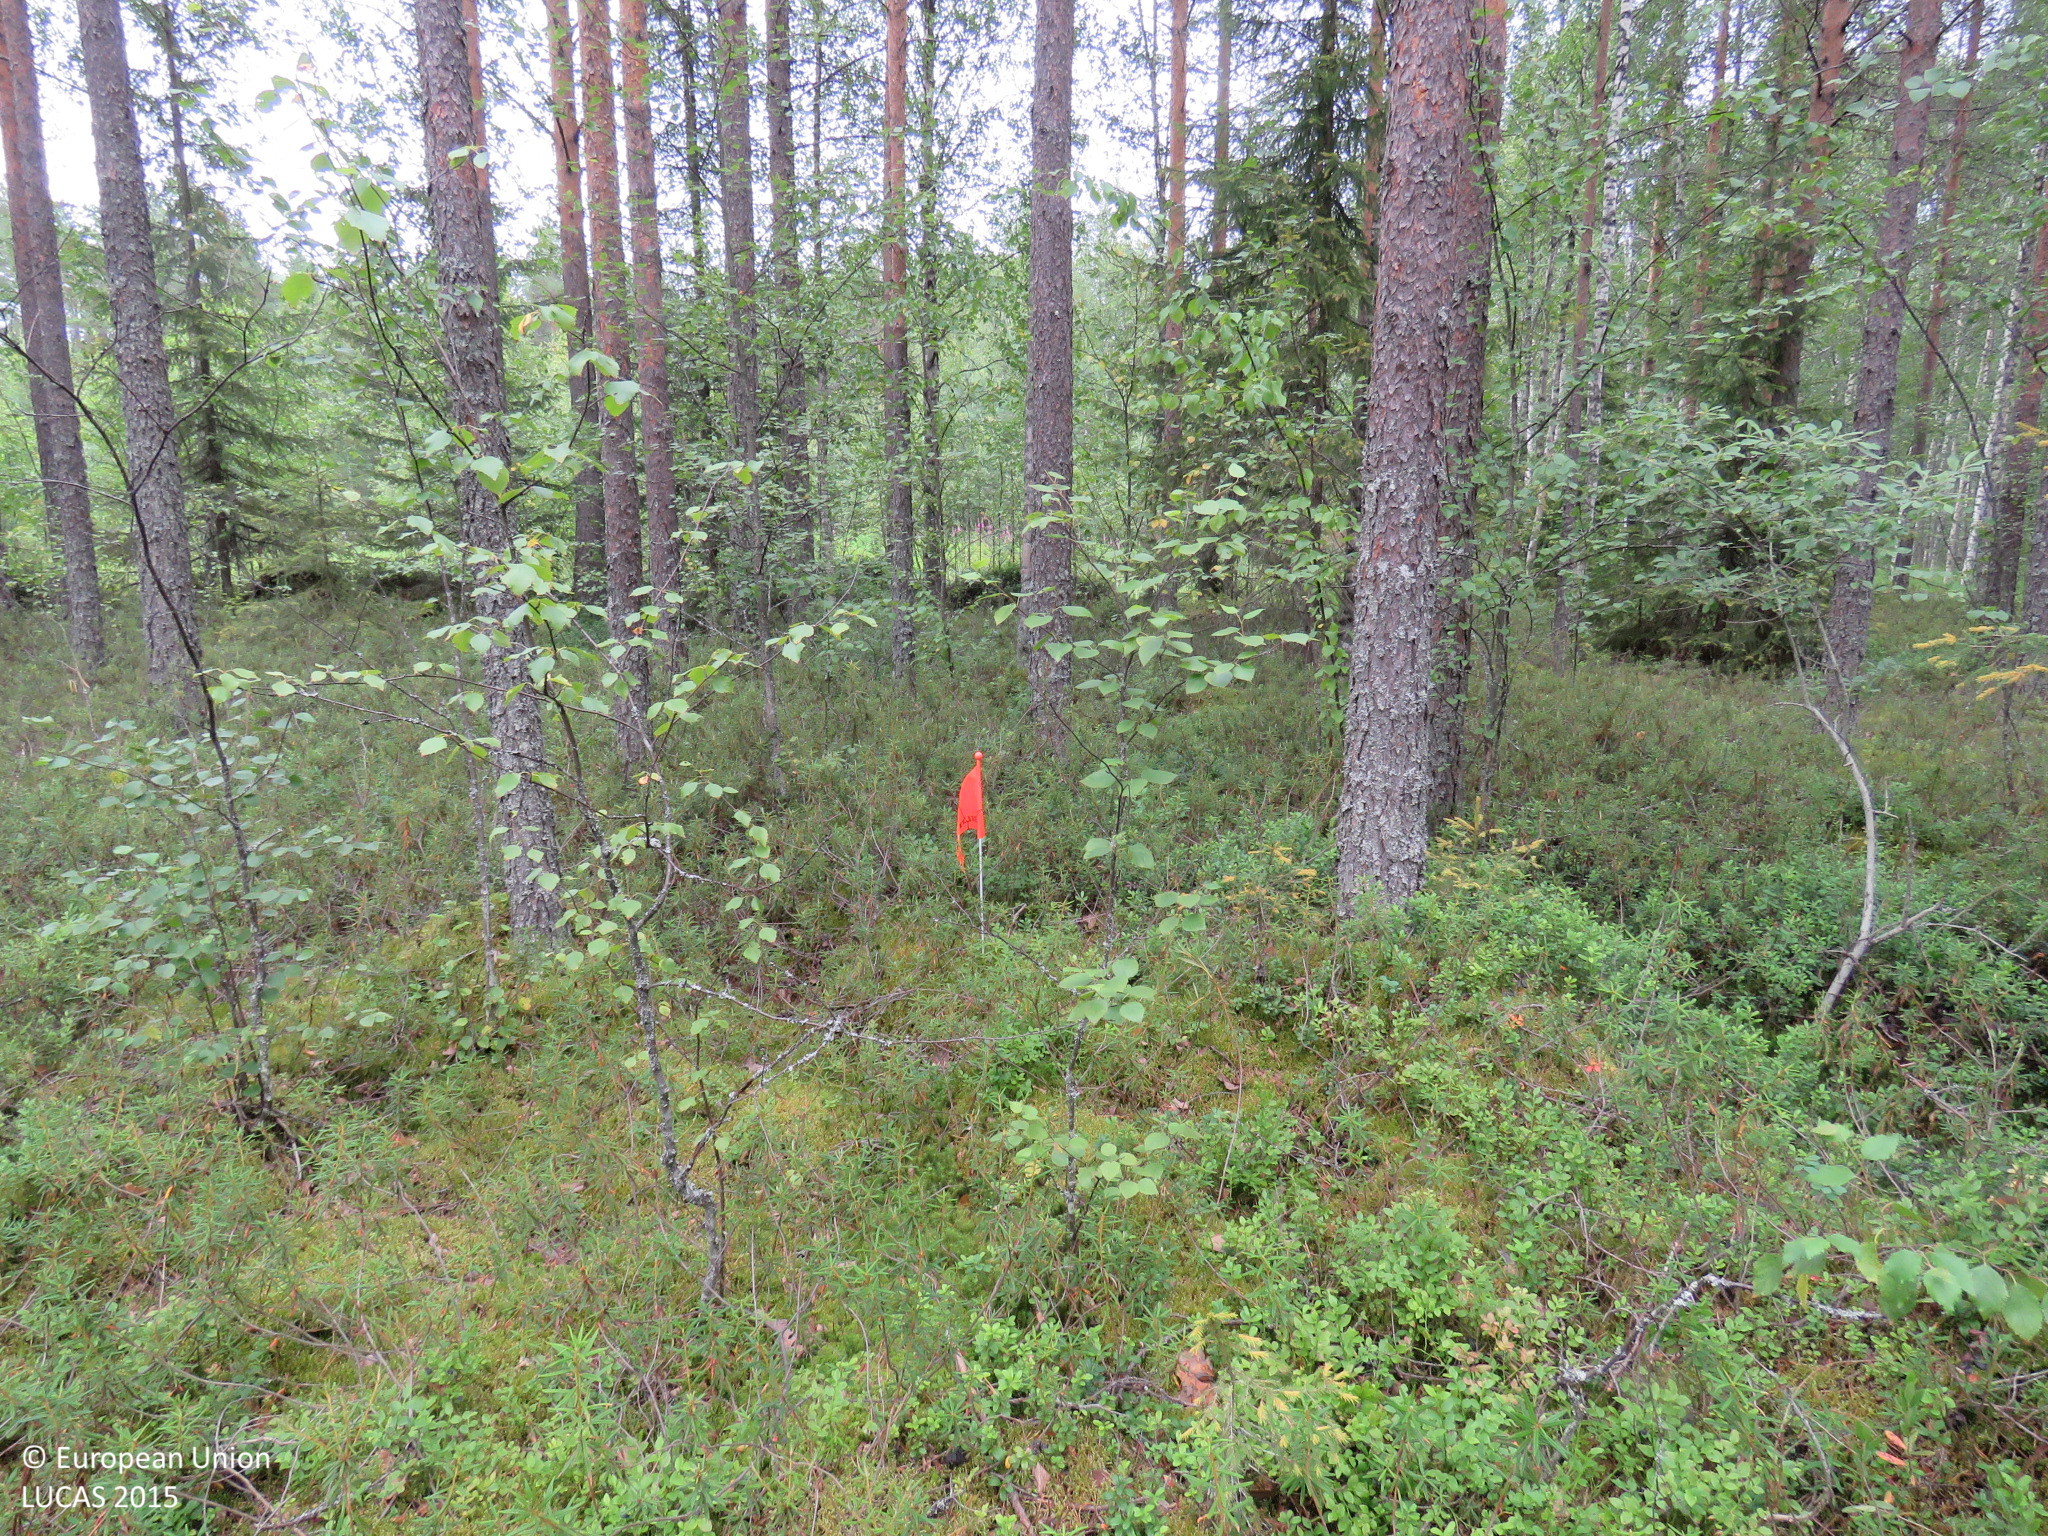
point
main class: Woodland
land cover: Other coniferous woodland
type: boreal forest
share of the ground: > 75 %
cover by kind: coniferous forest trees 65 %, shrubs 20 %, broadleaved forest trees 15 %
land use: Forestry
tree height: > 5 m
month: July
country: FI
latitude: 64.6040
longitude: 26.6474
